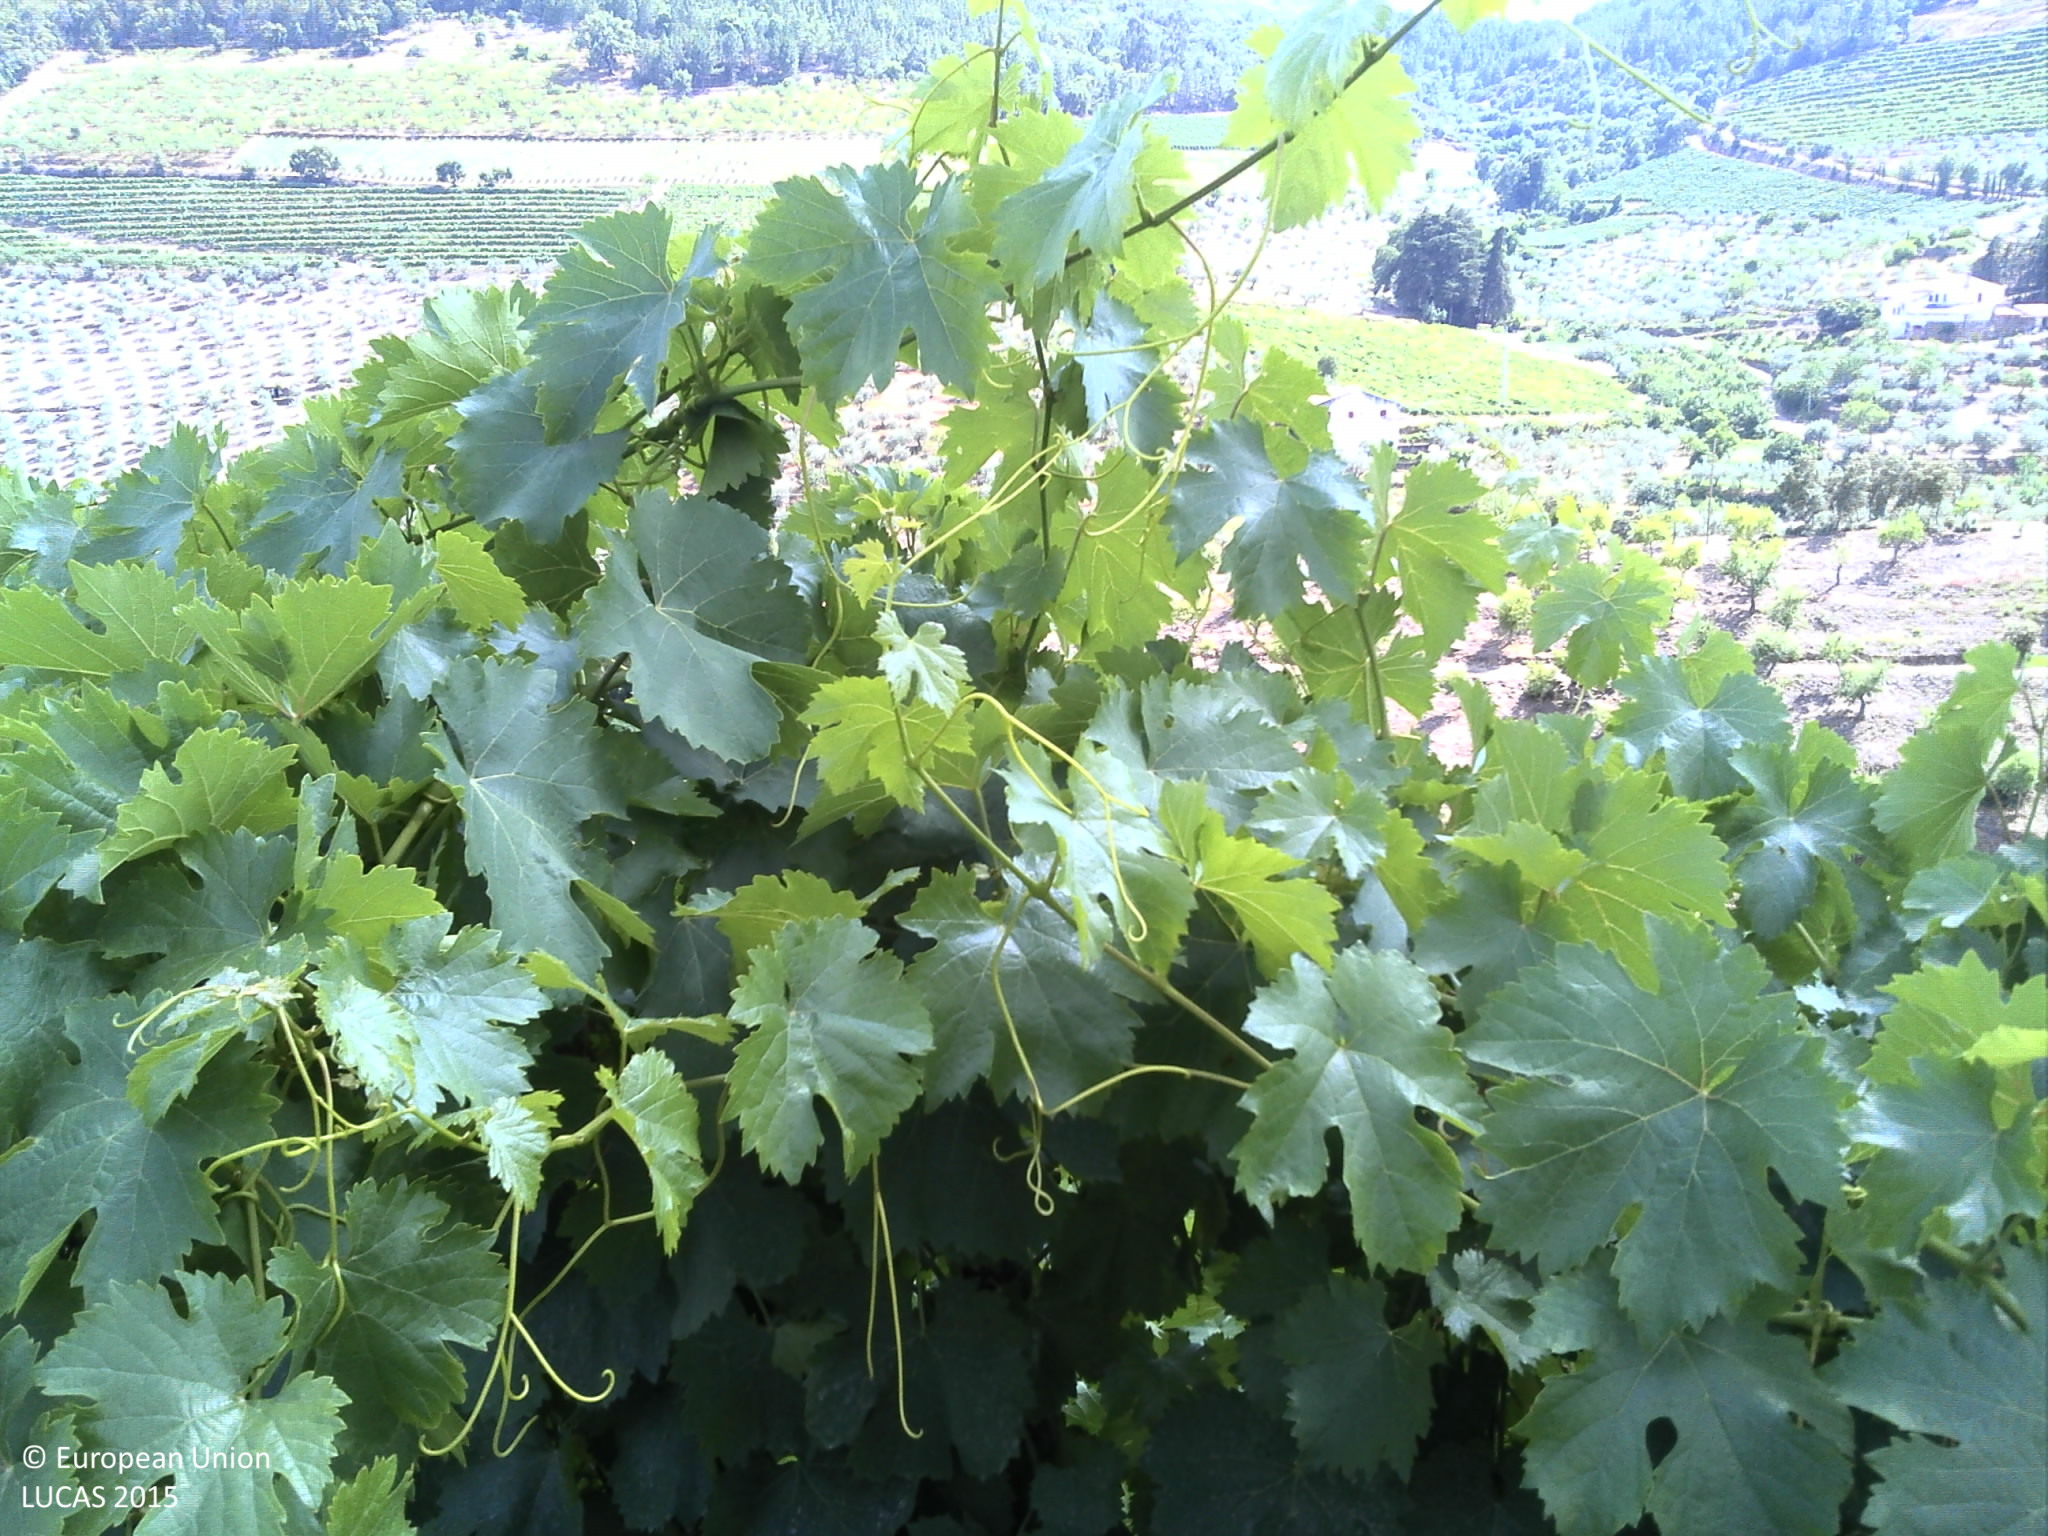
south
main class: Cropland
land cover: Vineyards
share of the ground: 10 - 25 %
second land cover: Other bare soil
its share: > 75 %
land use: Agriculture (excluding fallow land and kitchen gardens)
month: June
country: PT
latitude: 41.0690
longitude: -6.8245
